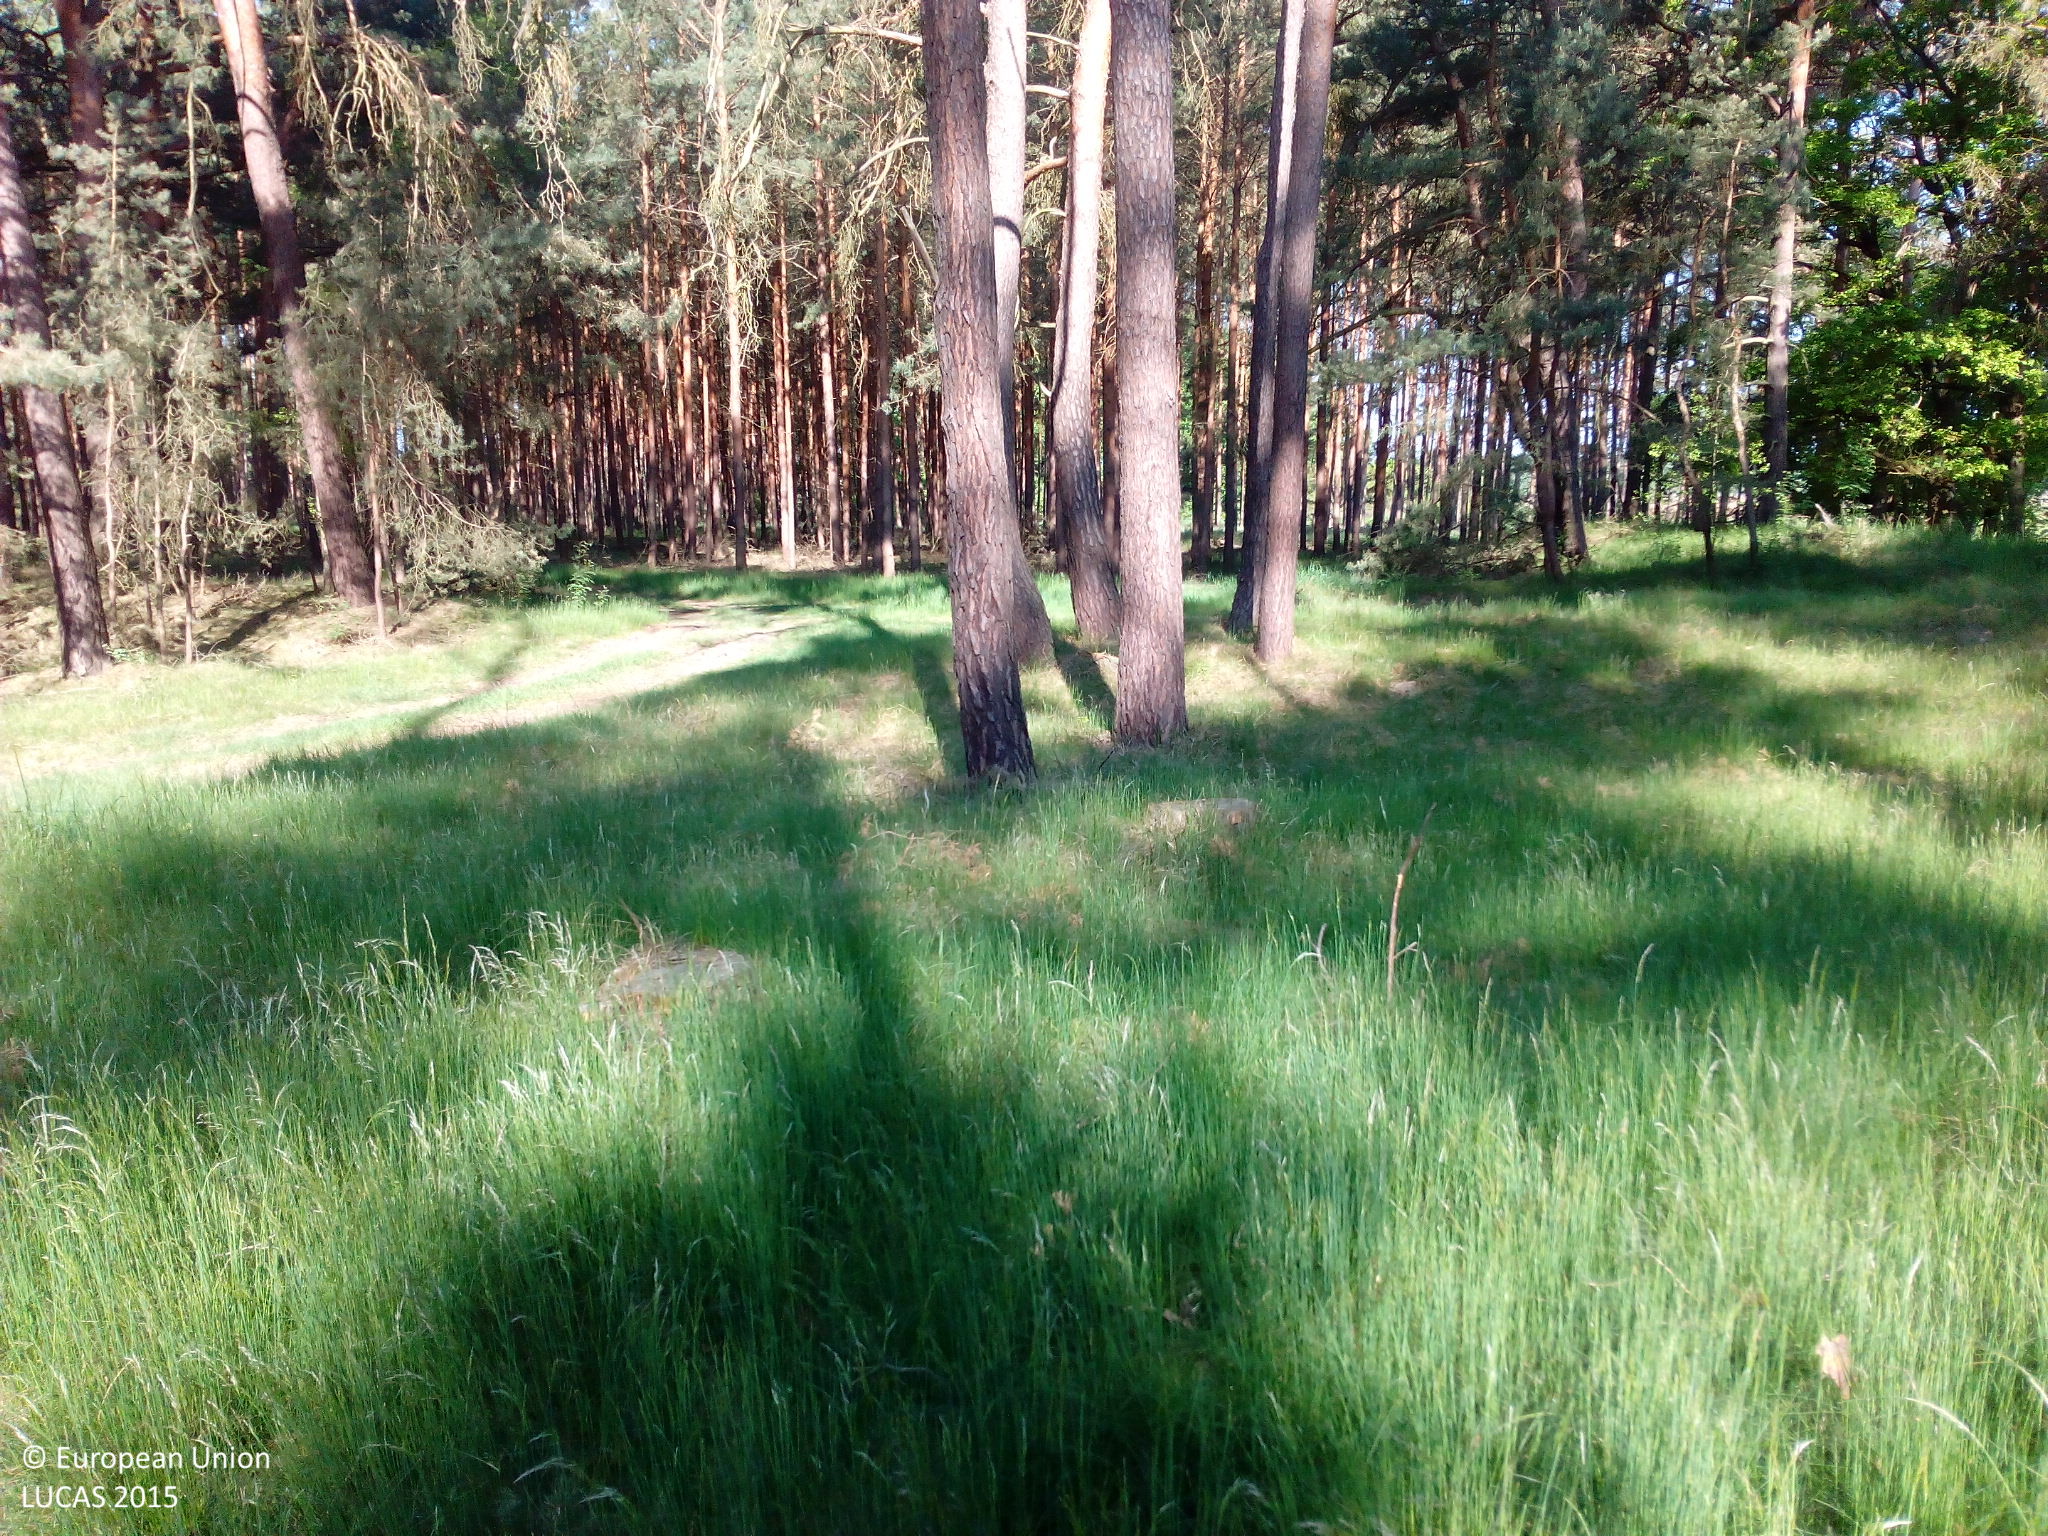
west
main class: Woodland
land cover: Pine dominated coniferous woodland
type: hemiboreal forest and nemoral coniferous forest and mixed broadleaved-coniferous forest
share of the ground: > 75 %
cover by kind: coniferous forest trees 75 %, herbaceous plants 25 %
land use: Forestry
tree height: > 5 m
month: May
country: DE
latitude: 52.1217
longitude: 13.0817
